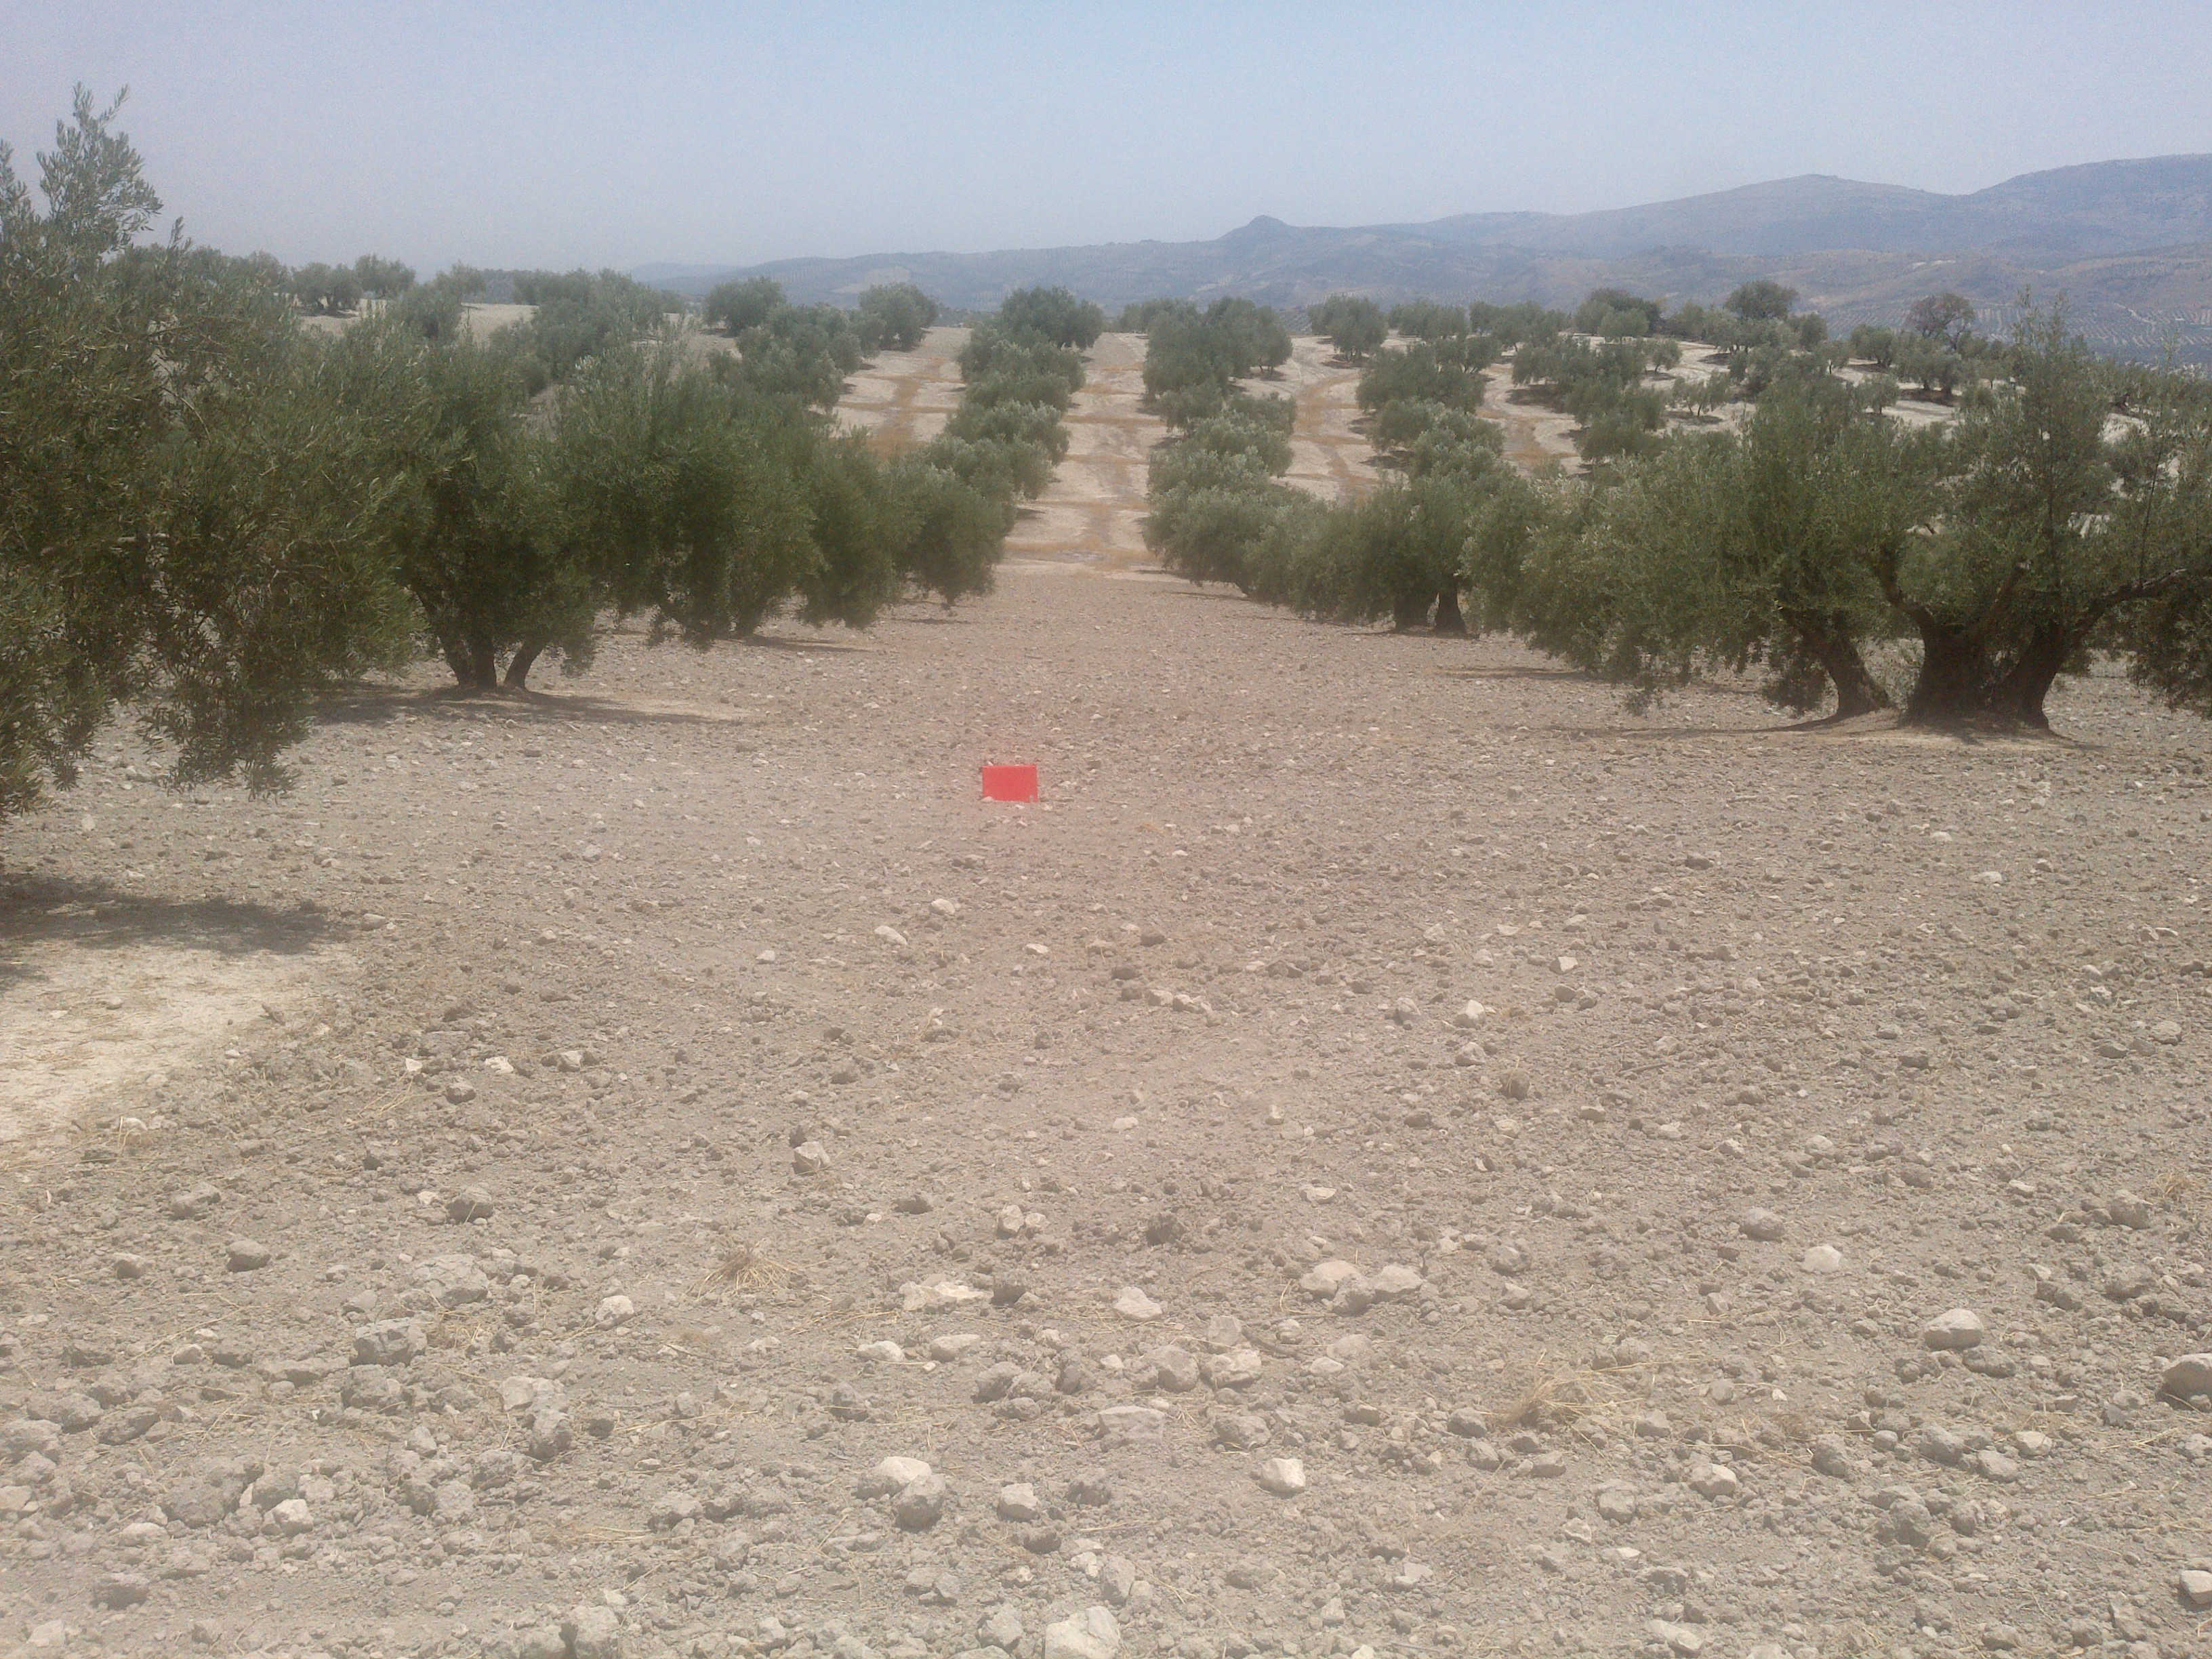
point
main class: Cropland
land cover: Olive groves
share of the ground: 25 - 50 %
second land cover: Other bare soil
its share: > 75 %
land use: Agriculture (excluding fallow land and kitchen gardens)
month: June
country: ES
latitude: 37.6036
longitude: -4.2642
